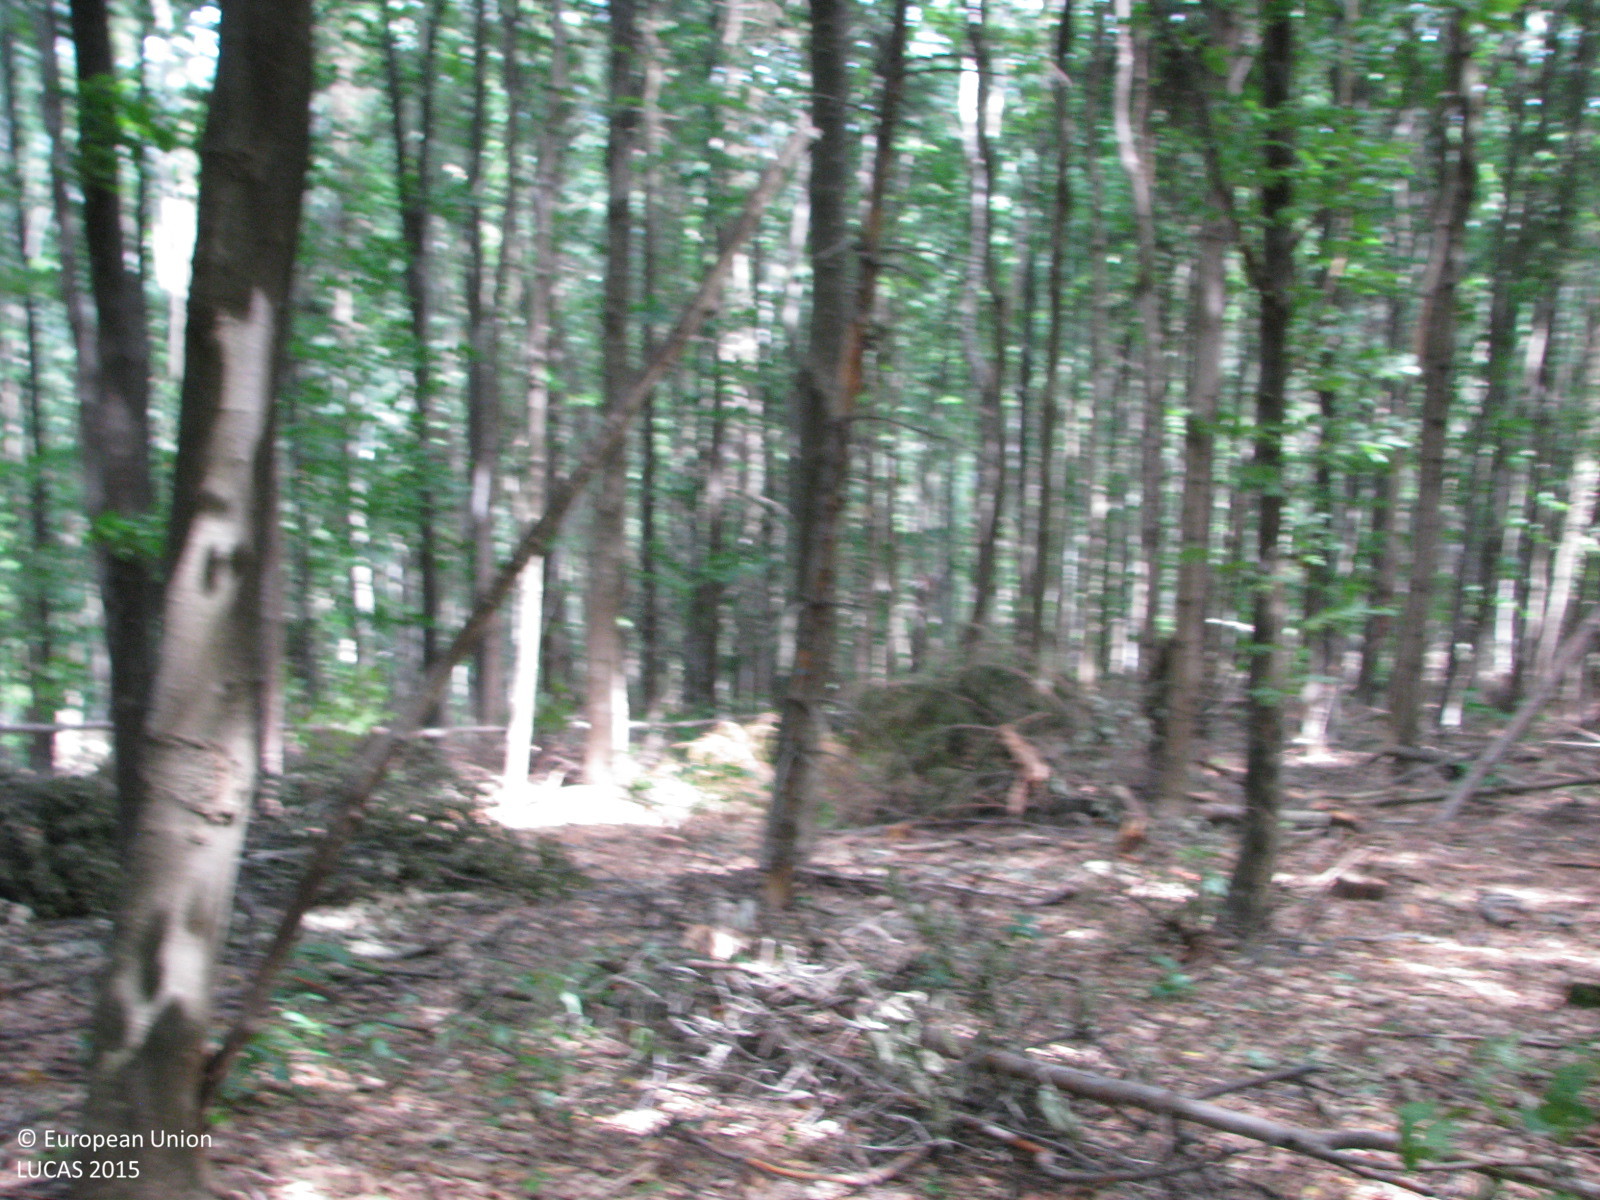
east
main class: Woodland
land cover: Broadleaved woodland
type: beech forest
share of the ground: > 75 %
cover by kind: broadleaved forest trees 75 %, unconsolidated bare surface 20 %, herbaceous plants 5 %
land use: Forestry
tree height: > 5 m
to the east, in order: Broadleaved woodland
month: August
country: BG
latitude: 42.8109
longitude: 26.1951
